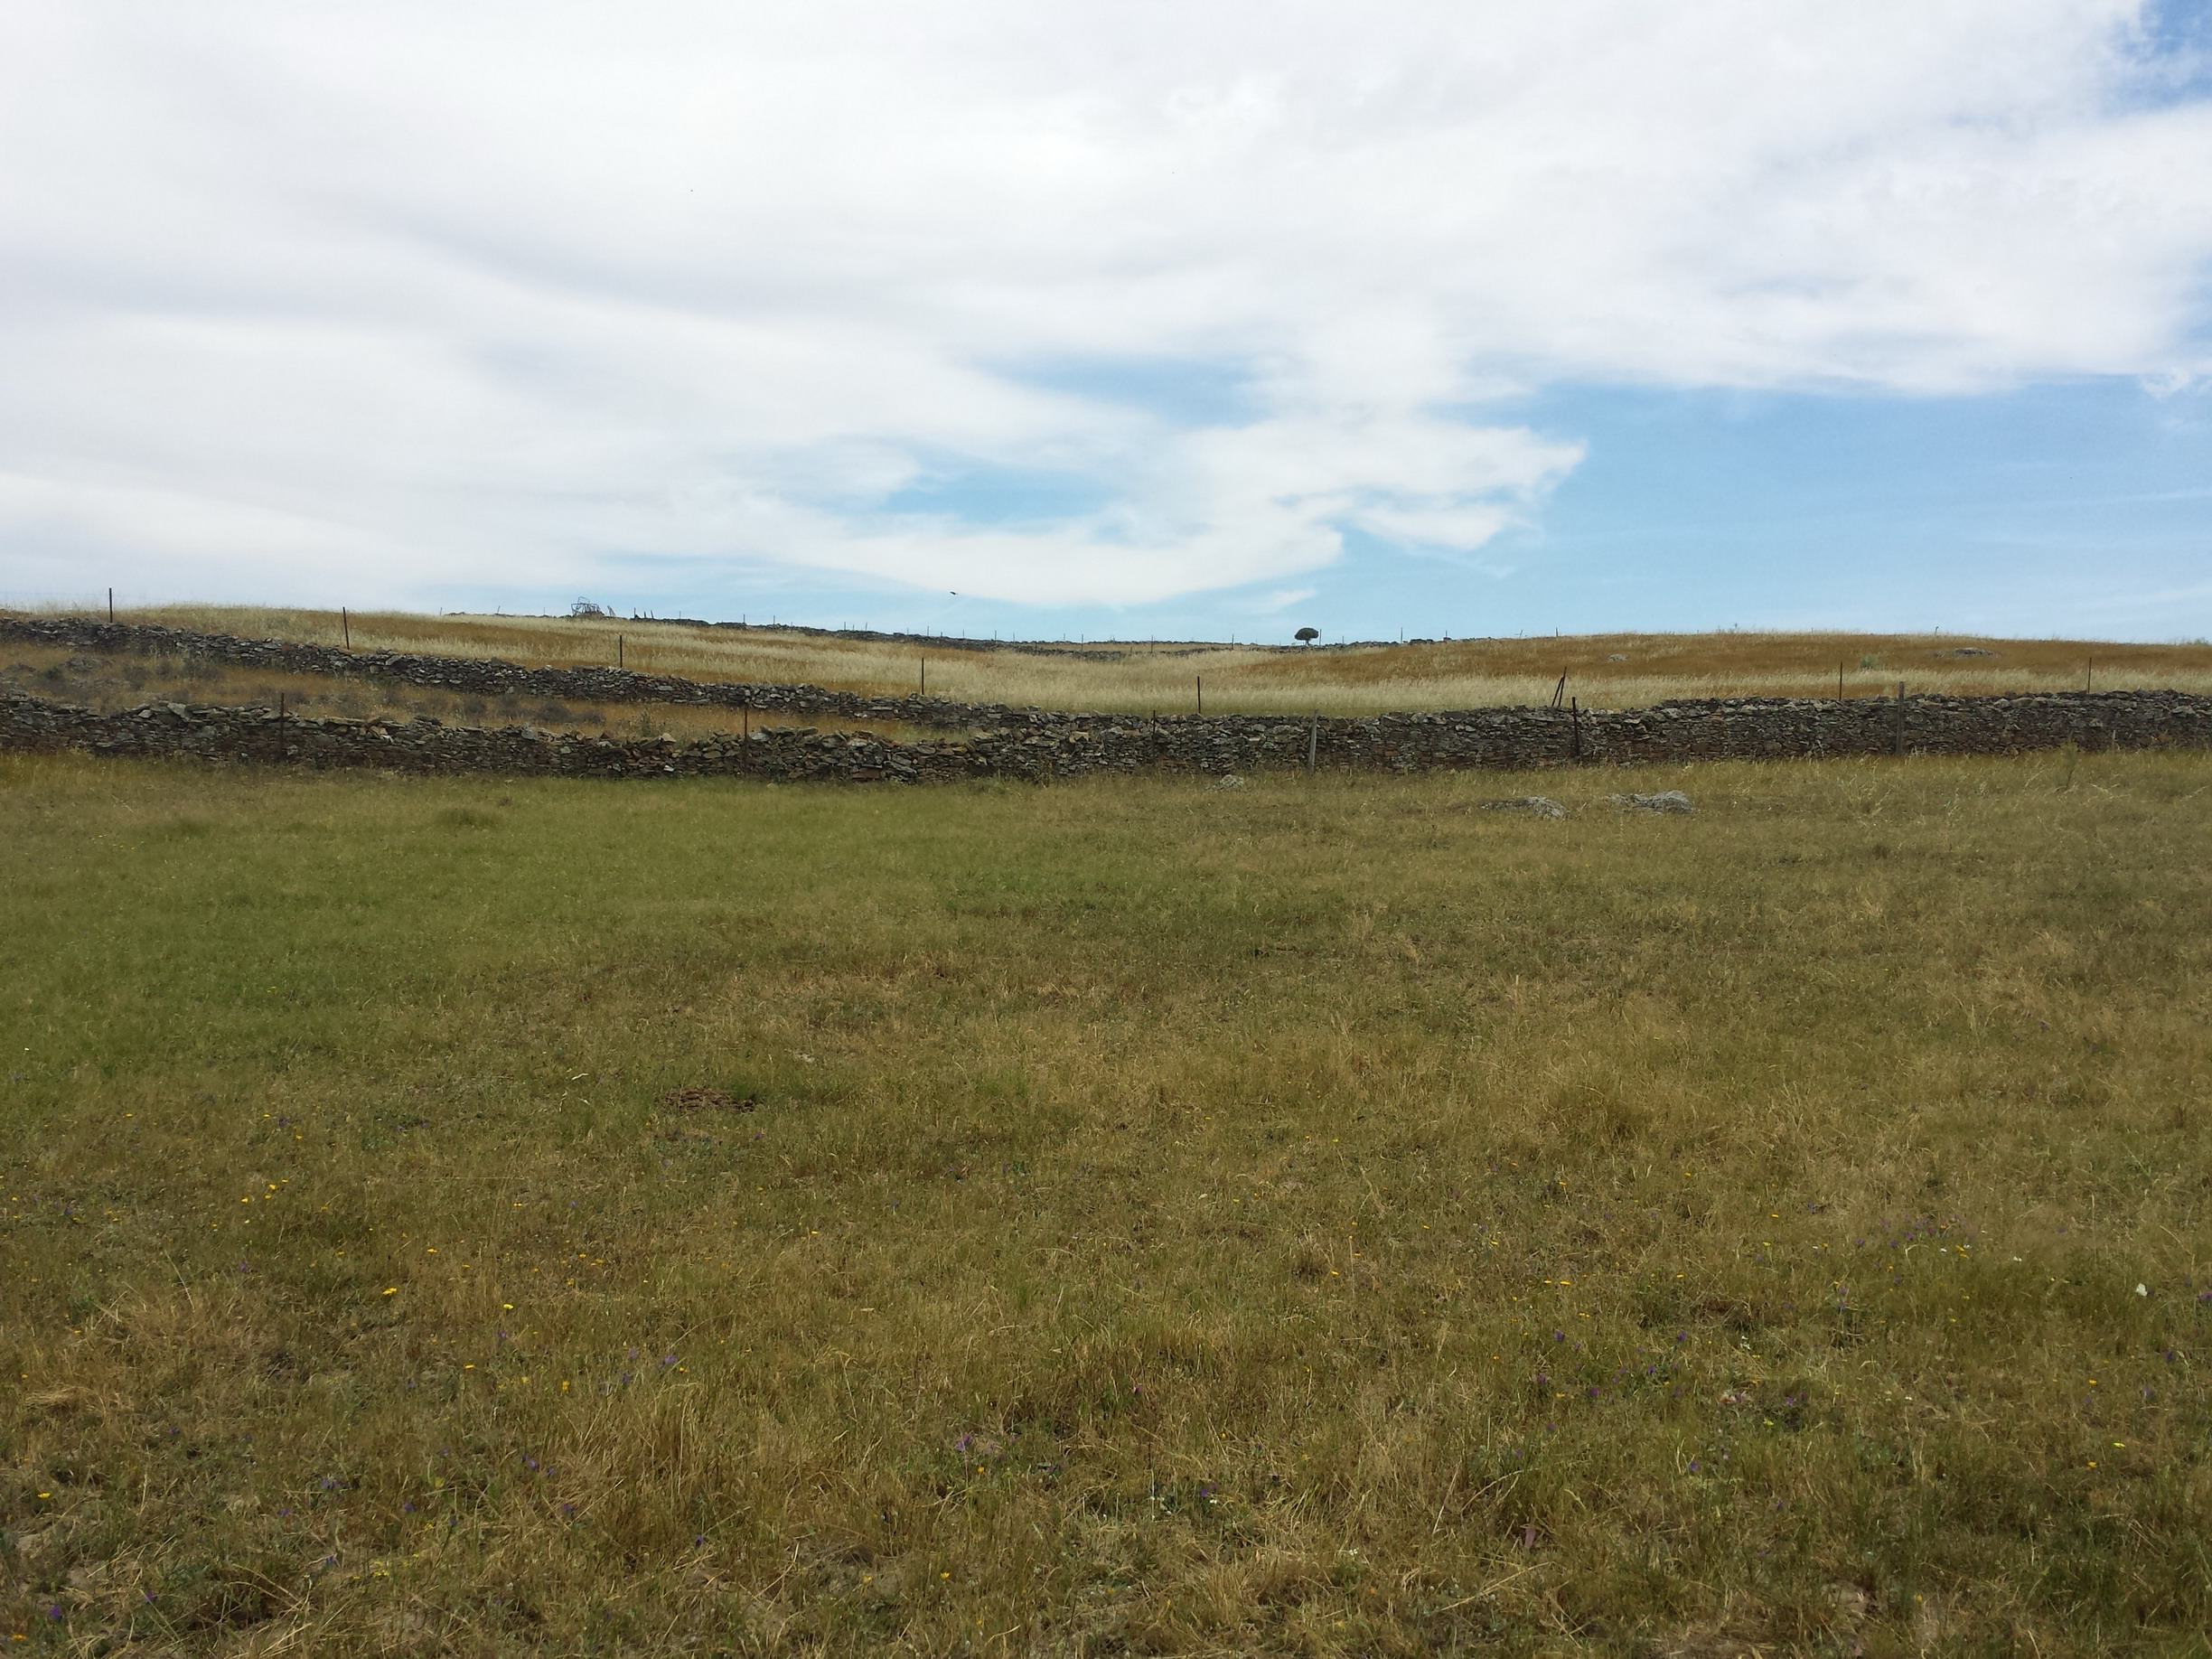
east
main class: Grassland
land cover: Grassland with sparse tree/shrub cover
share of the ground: > 75 %
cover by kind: herbaceous plants 95 %, broadleaved forest trees 5 %
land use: Semi-natural and natural areas not in use
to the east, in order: Grassland with sparse tree/shrub cover; Dry stone walls; Grass margins; Tracks; Rock outcrops; Dry stone walls; Grassland without tree/shrub cover; Dry stone walls; Tracks; Dry stone walls; Grassland without tree/shrub cover; Dry stone walls; Grassland without tree/shrub cover; Dry stone walls; Grassland without tree/shrub cover
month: May
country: ES
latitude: 39.5355
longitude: -7.0590
